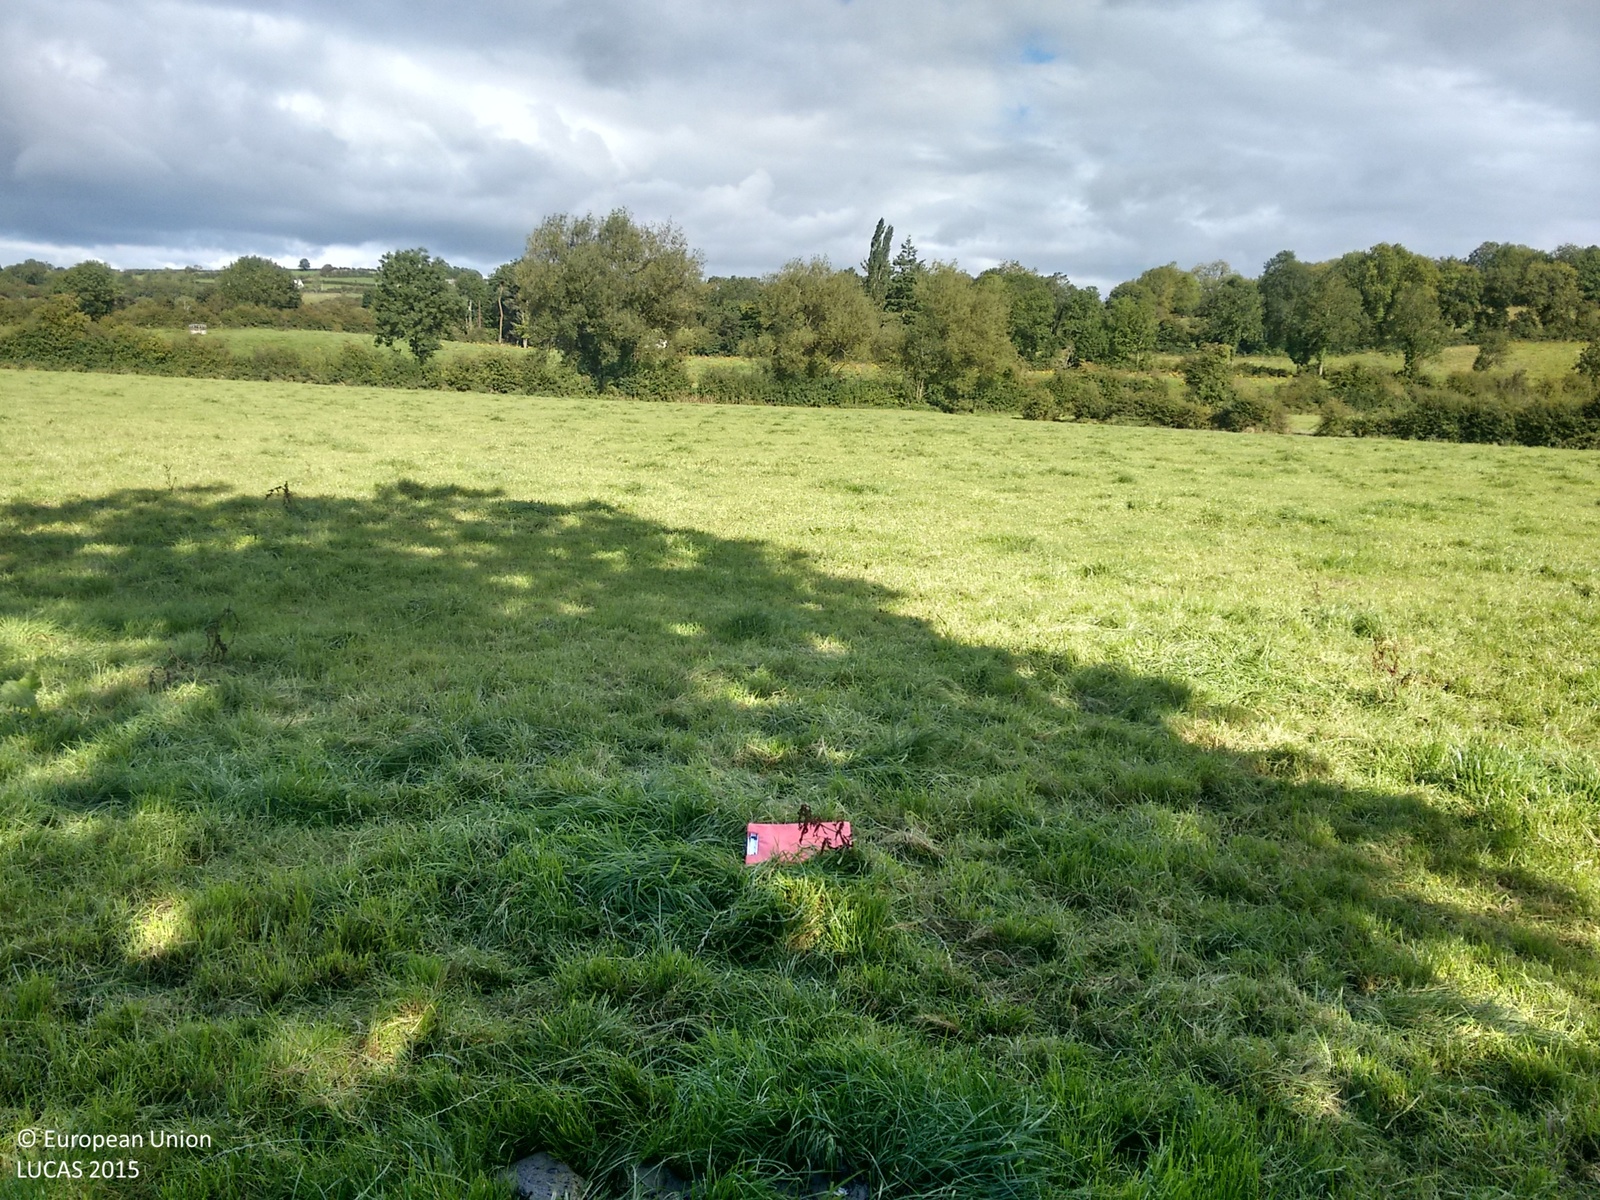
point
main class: Grassland
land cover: Grassland without tree/shrub cover
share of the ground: > 75 %
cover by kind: herbaceous plants 95 %, shrubs 5 %
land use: Agriculture (excluding fallow land and kitchen gardens)
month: September
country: IE
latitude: 54.2335
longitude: -6.8425
